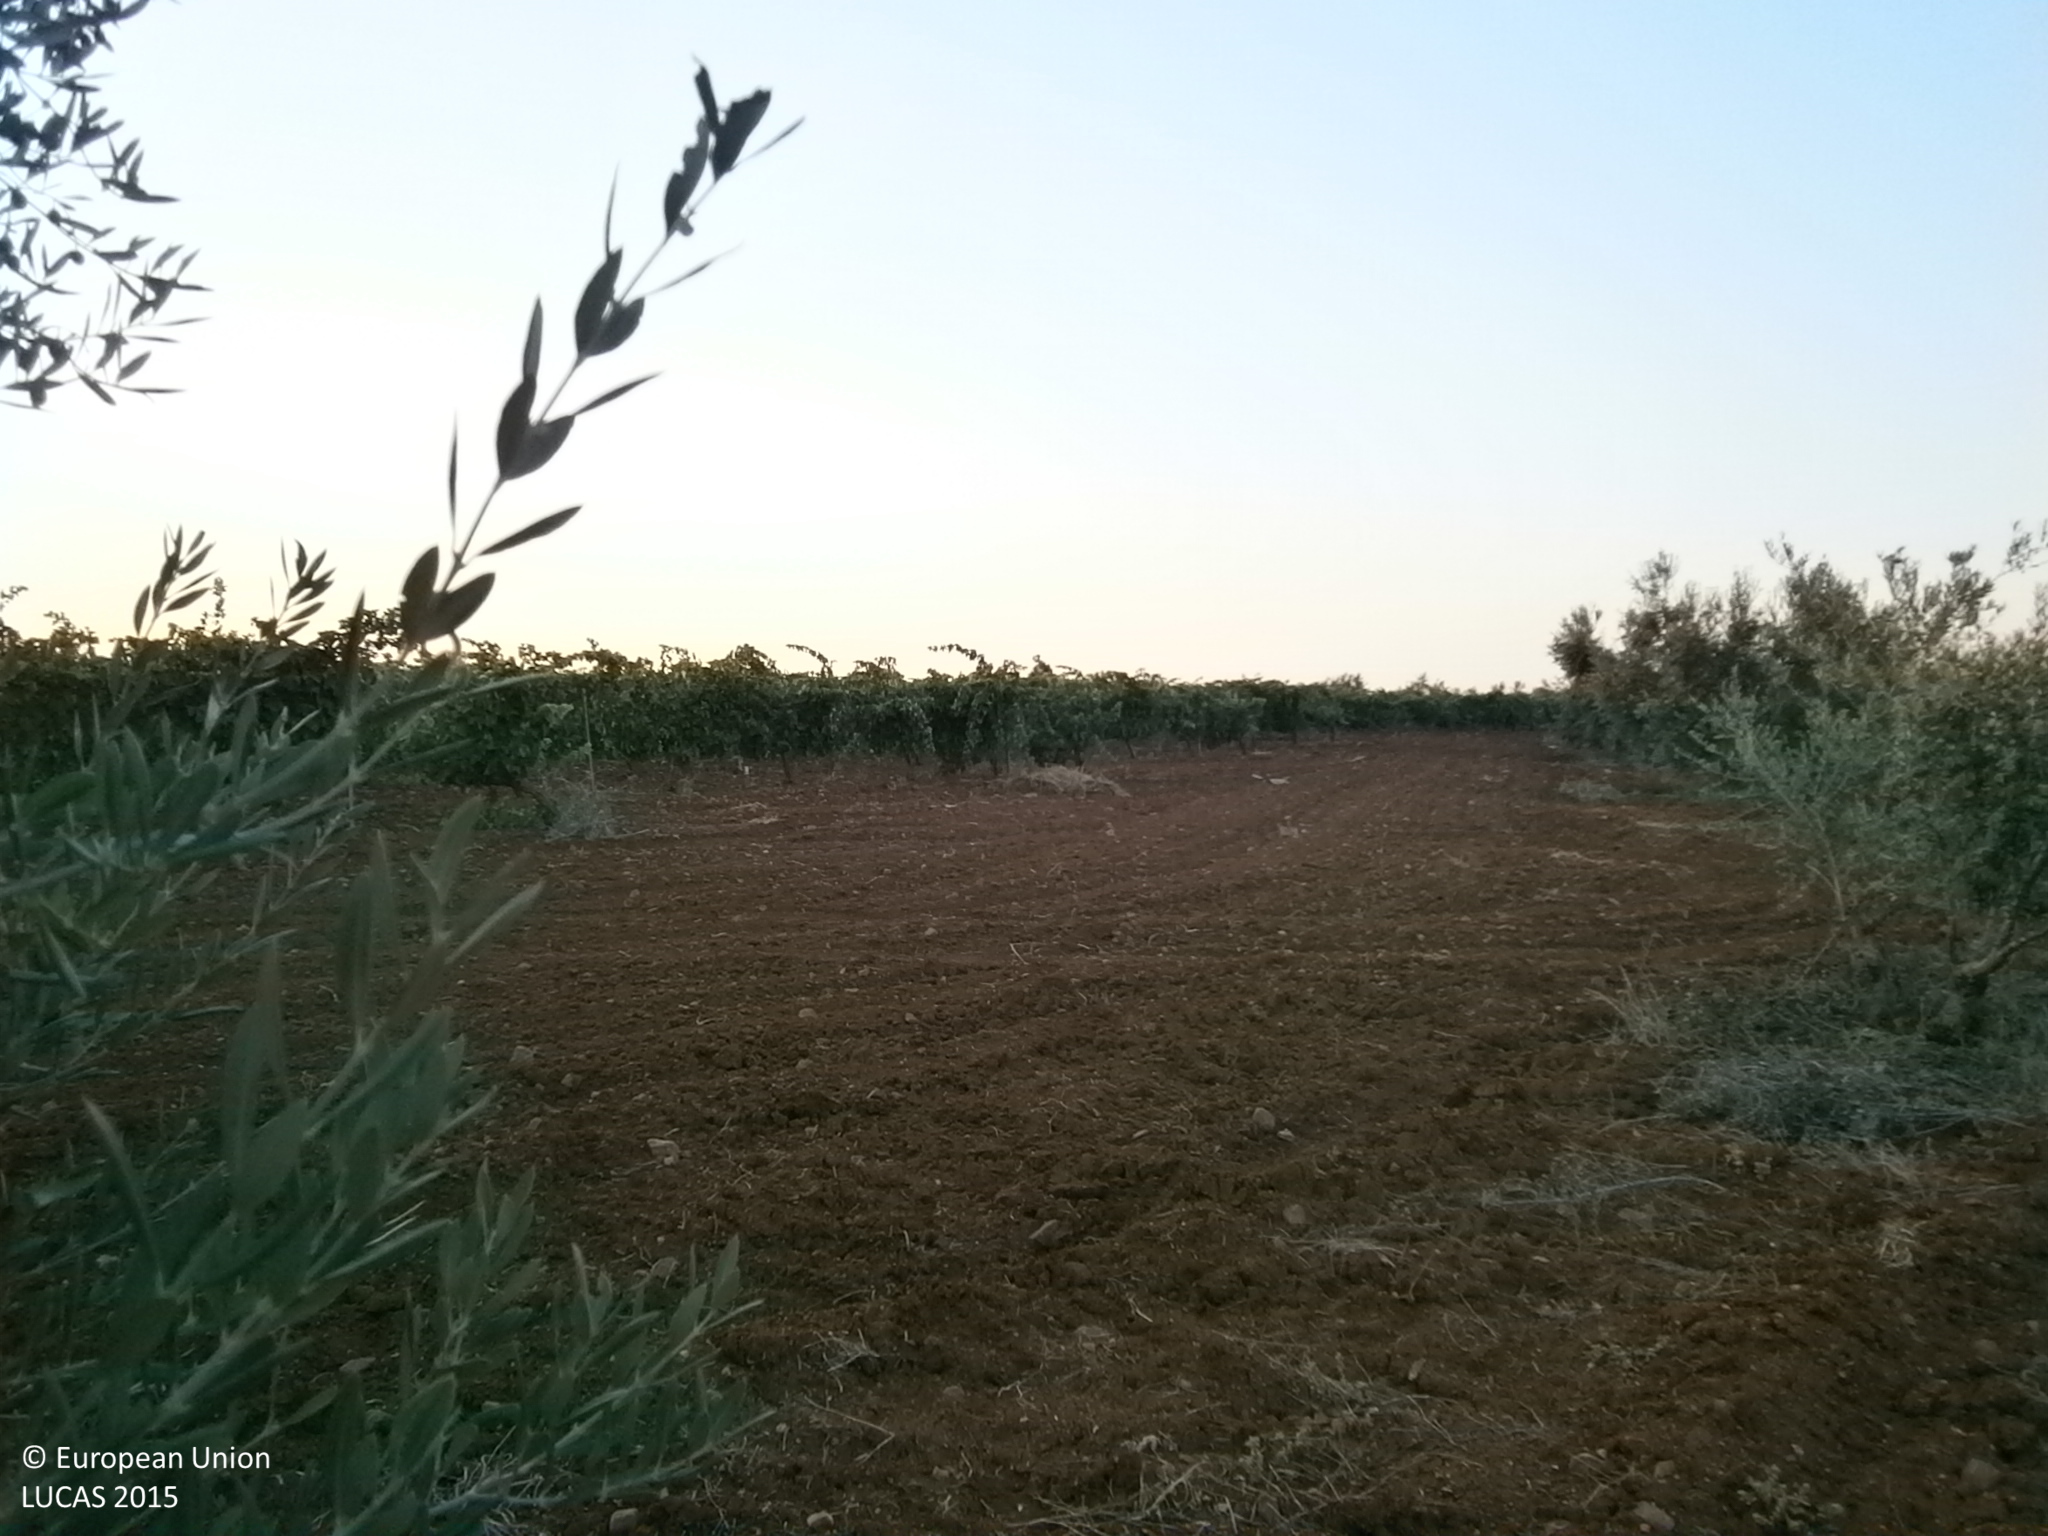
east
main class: Cropland
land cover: Olive groves
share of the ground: 25 - 50 %
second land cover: Other bare soil
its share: > 75 %
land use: Agriculture (excluding fallow land and kitchen gardens)
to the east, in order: Olive groves; Other bare soil; Vineyards
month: June
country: ES
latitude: 38.6253
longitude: -6.6799
